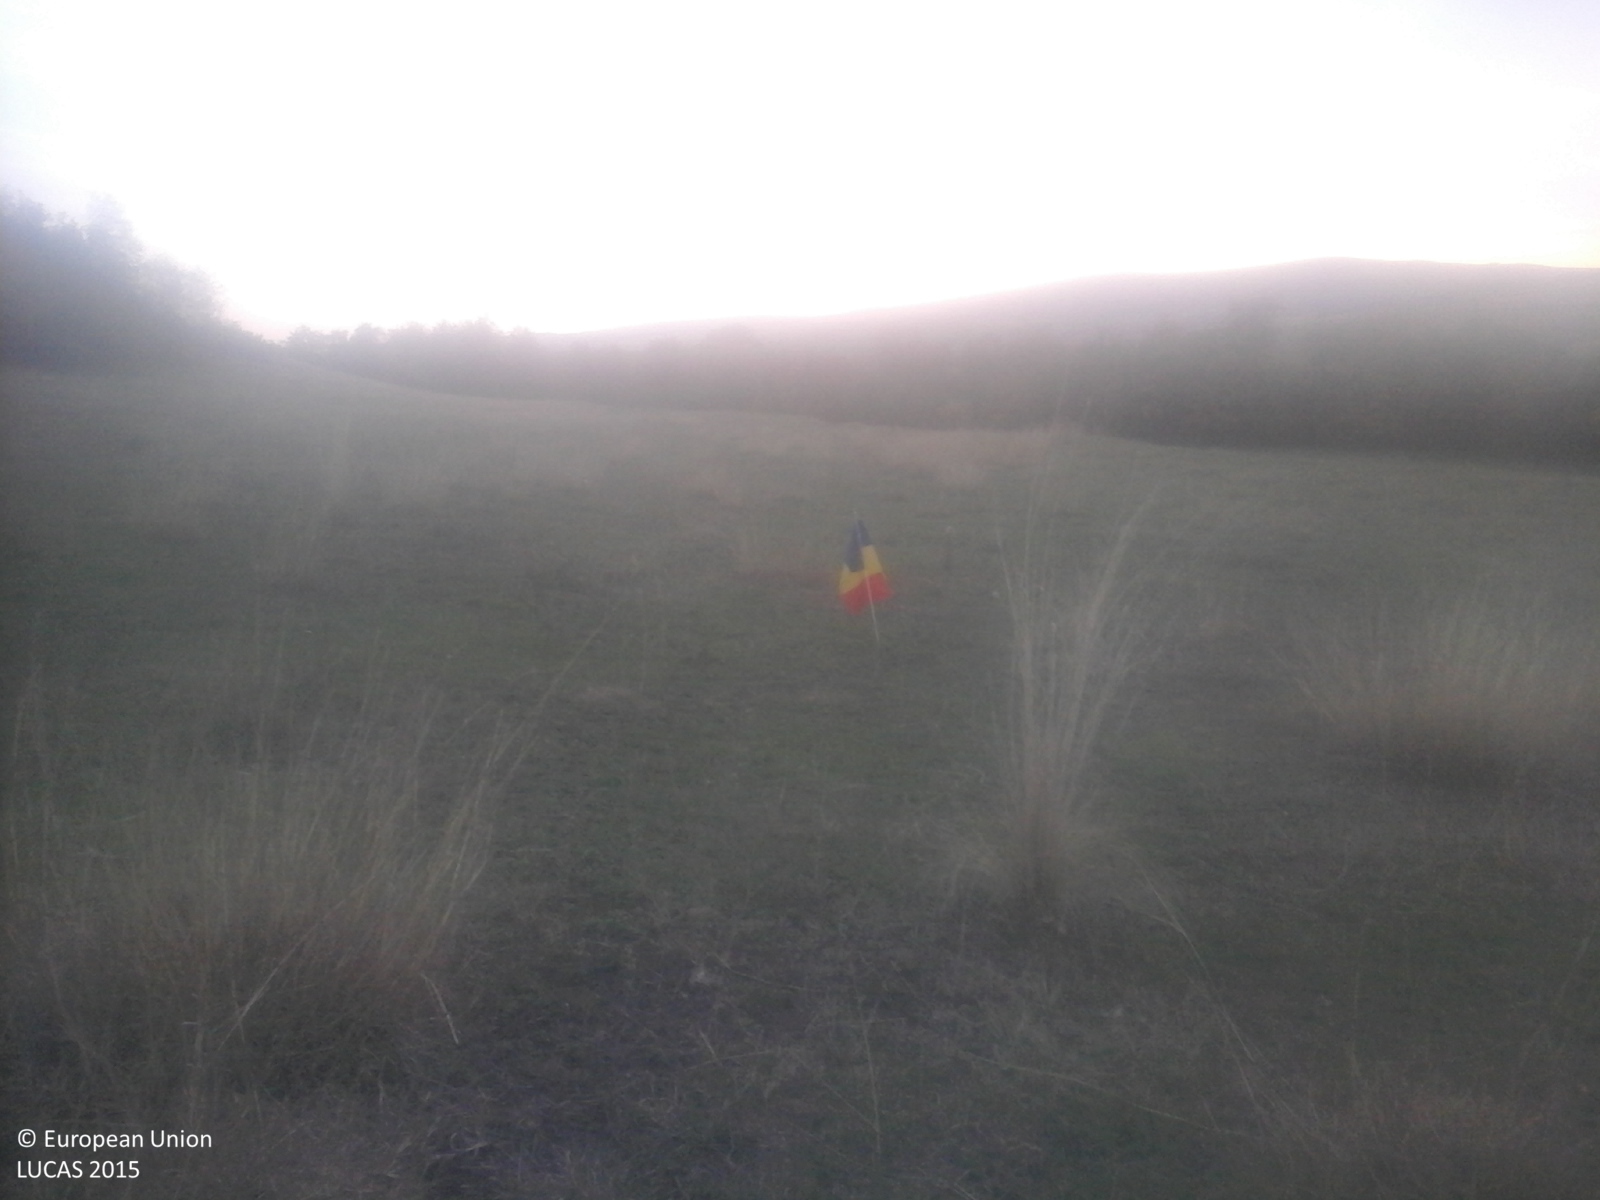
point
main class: Grassland
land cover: Grassland without tree/shrub cover
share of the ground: > 75 %
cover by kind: herbaceous plants 100 %
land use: Agriculture (excluding fallow land and kitchen gardens)
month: October
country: RO
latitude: 45.3661
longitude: 26.8724
